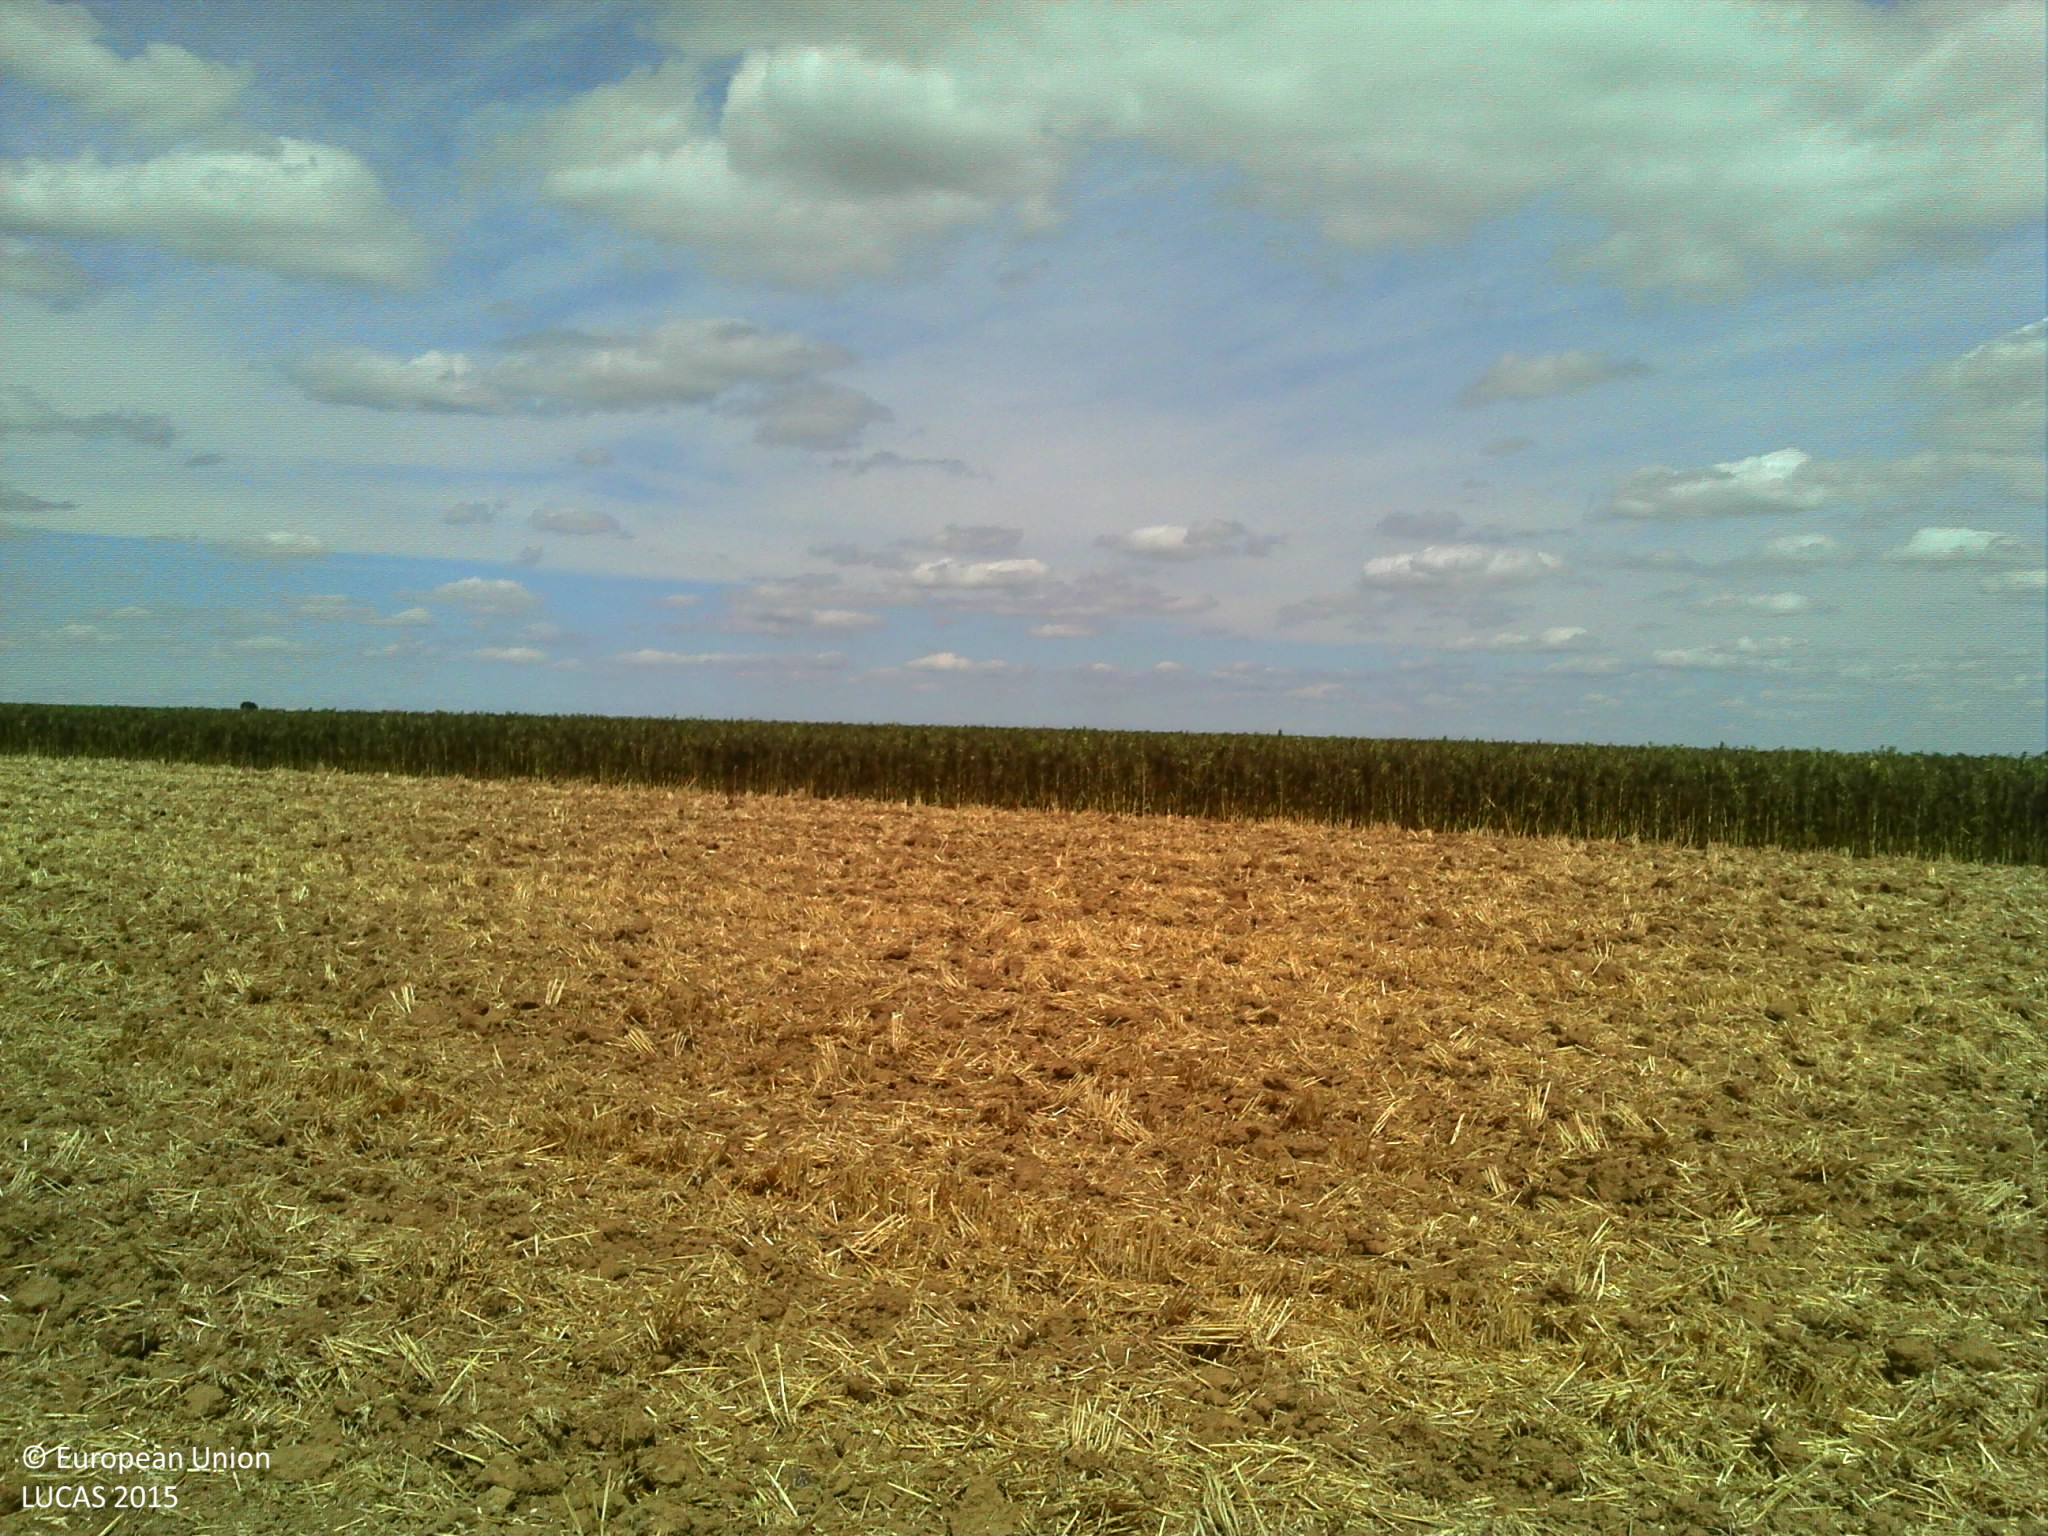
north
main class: Cropland
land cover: Barley
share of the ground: > 75 %
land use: Agriculture (excluding fallow land and kitchen gardens)
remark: Harvested field
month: July
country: FR
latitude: 49.0951
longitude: 2.8827
